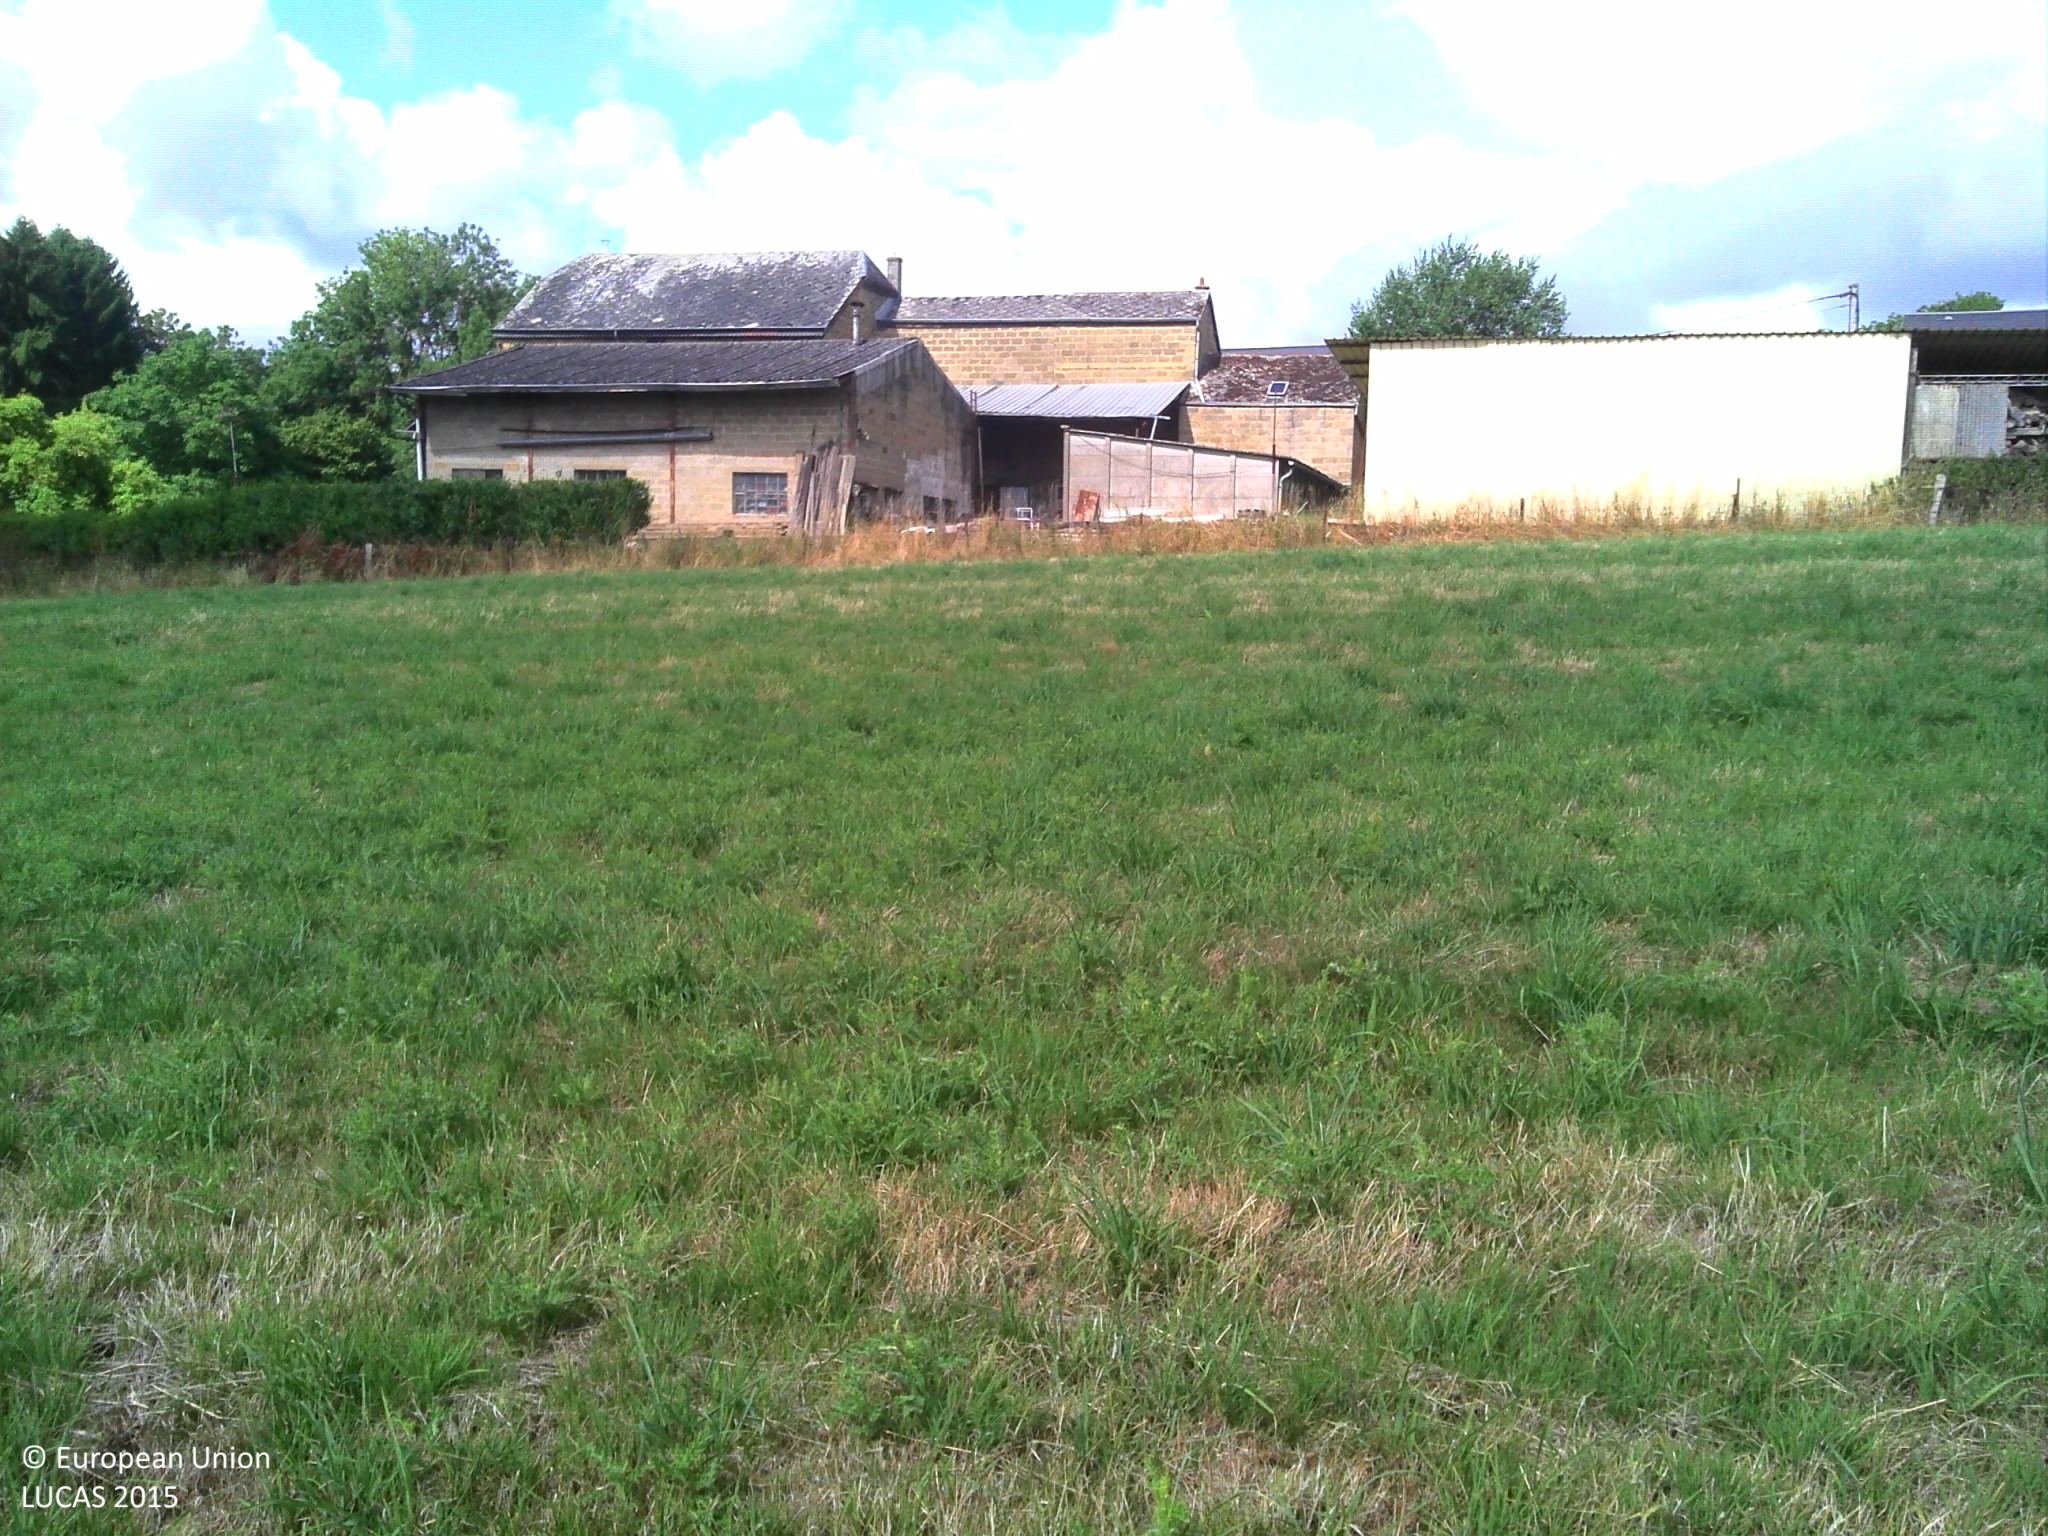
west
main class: Grassland
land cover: Grassland without tree/shrub cover
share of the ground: > 75 %
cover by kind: herbaceous plants 100 %
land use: Agriculture (excluding fallow land and kitchen gardens)
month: July
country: BE
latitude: 49.5407
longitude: 5.5903
